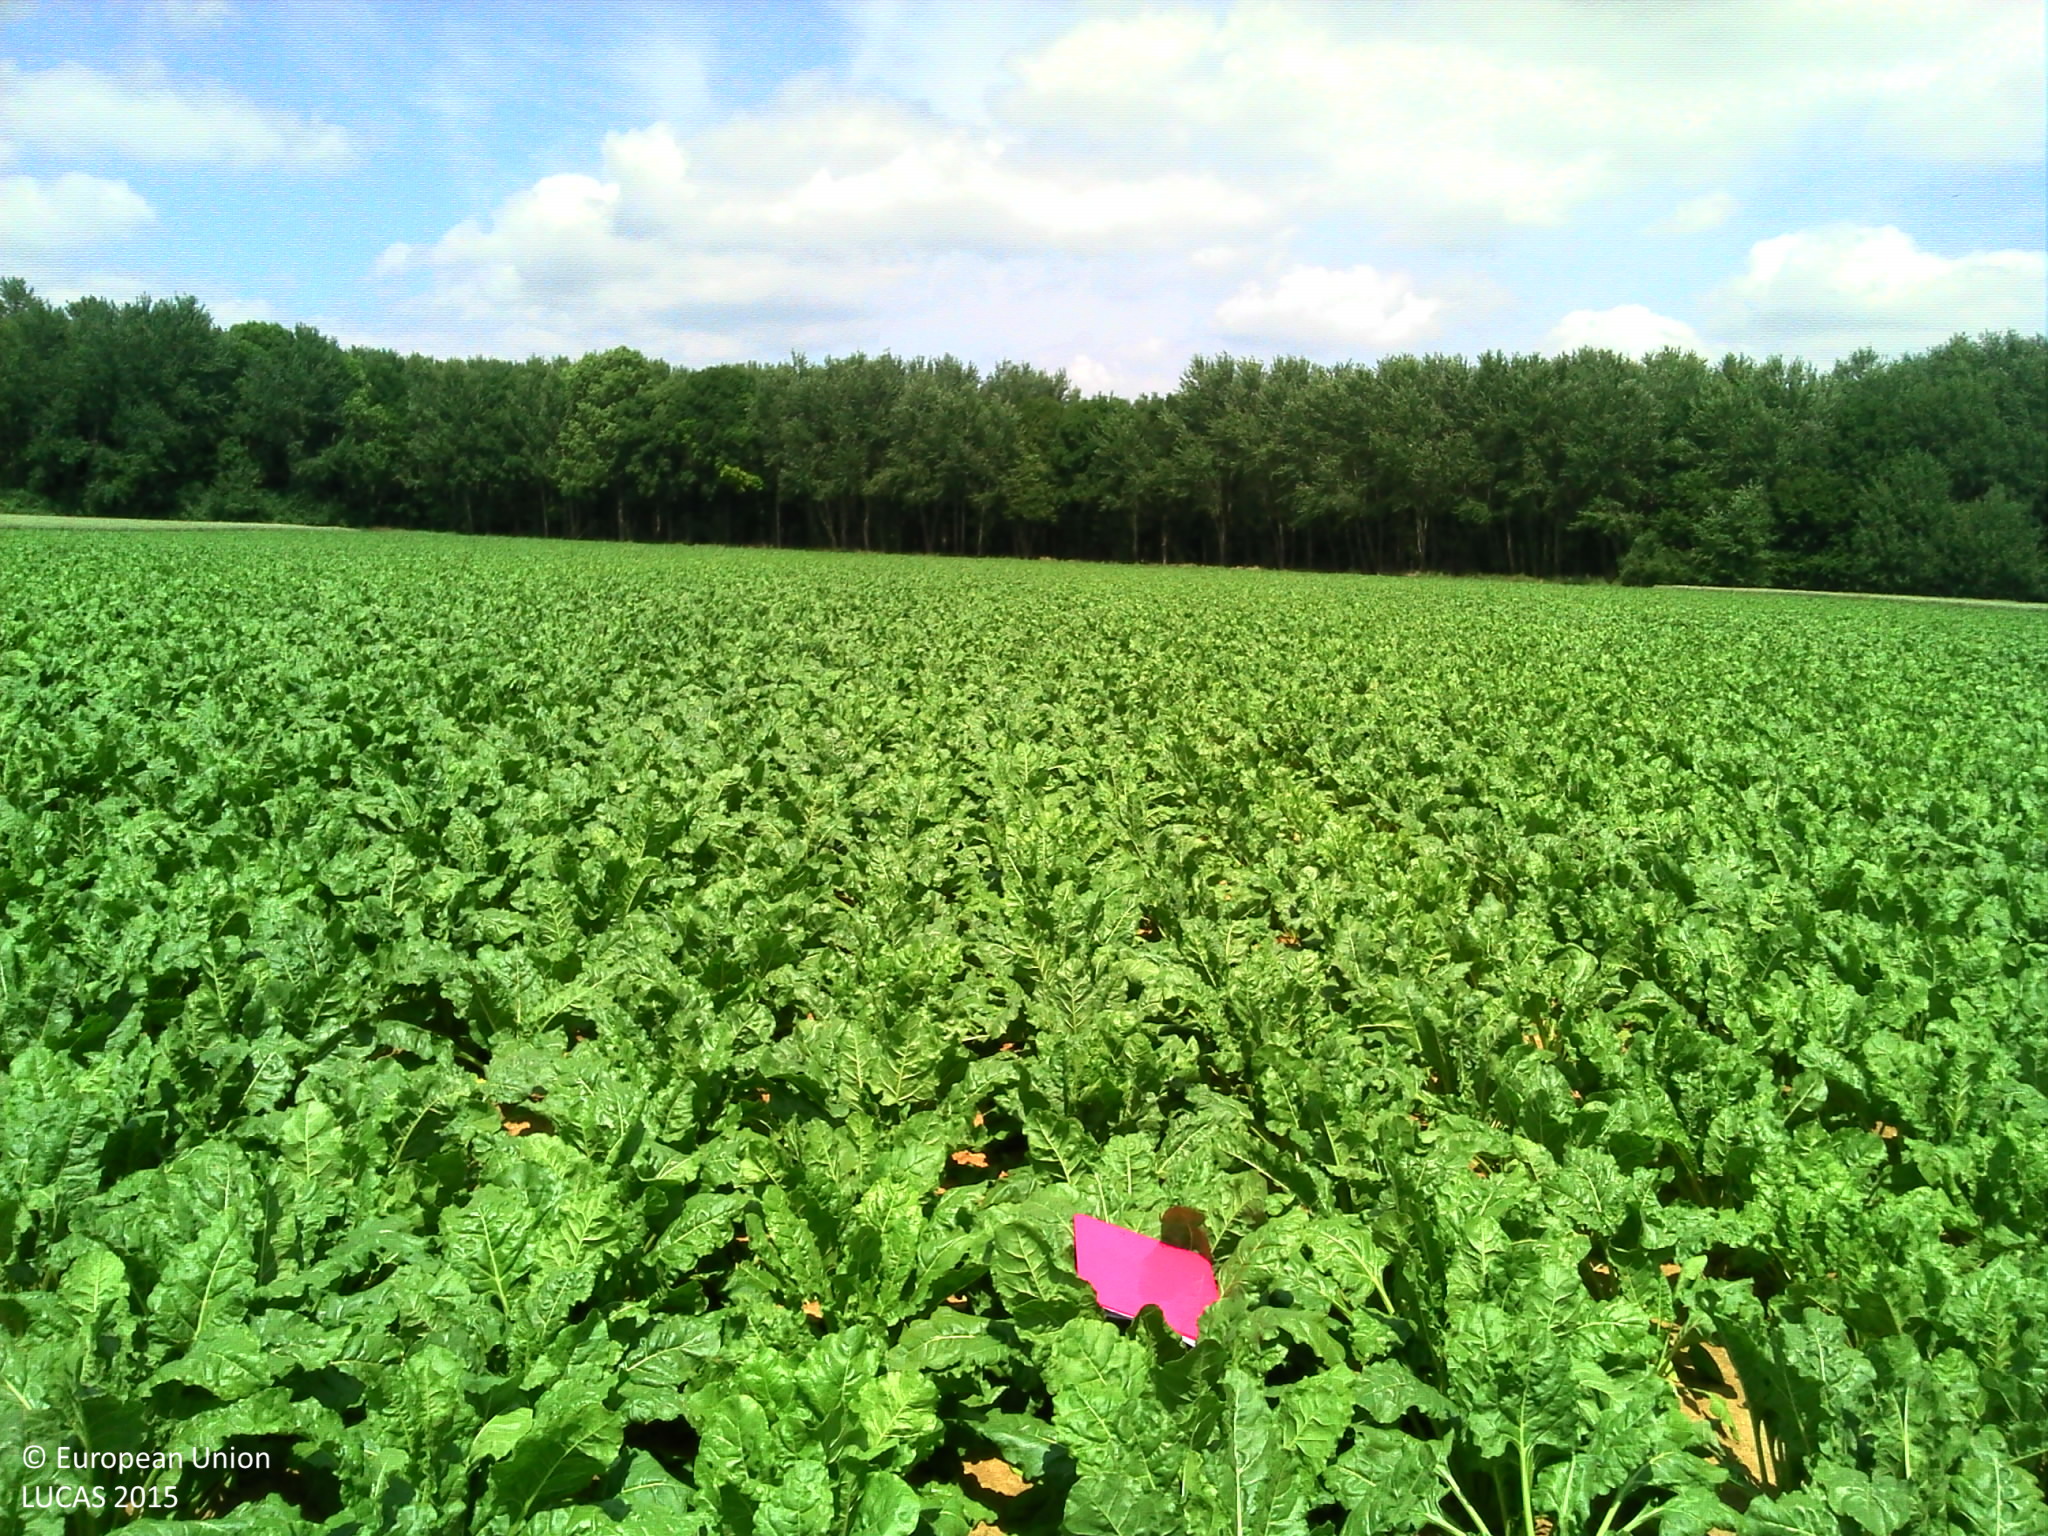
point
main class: Cropland
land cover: Sugar beet
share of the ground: > 75 %
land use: Agriculture (excluding fallow land and kitchen gardens)
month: June
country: FR
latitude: 49.6728
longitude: 2.8812
